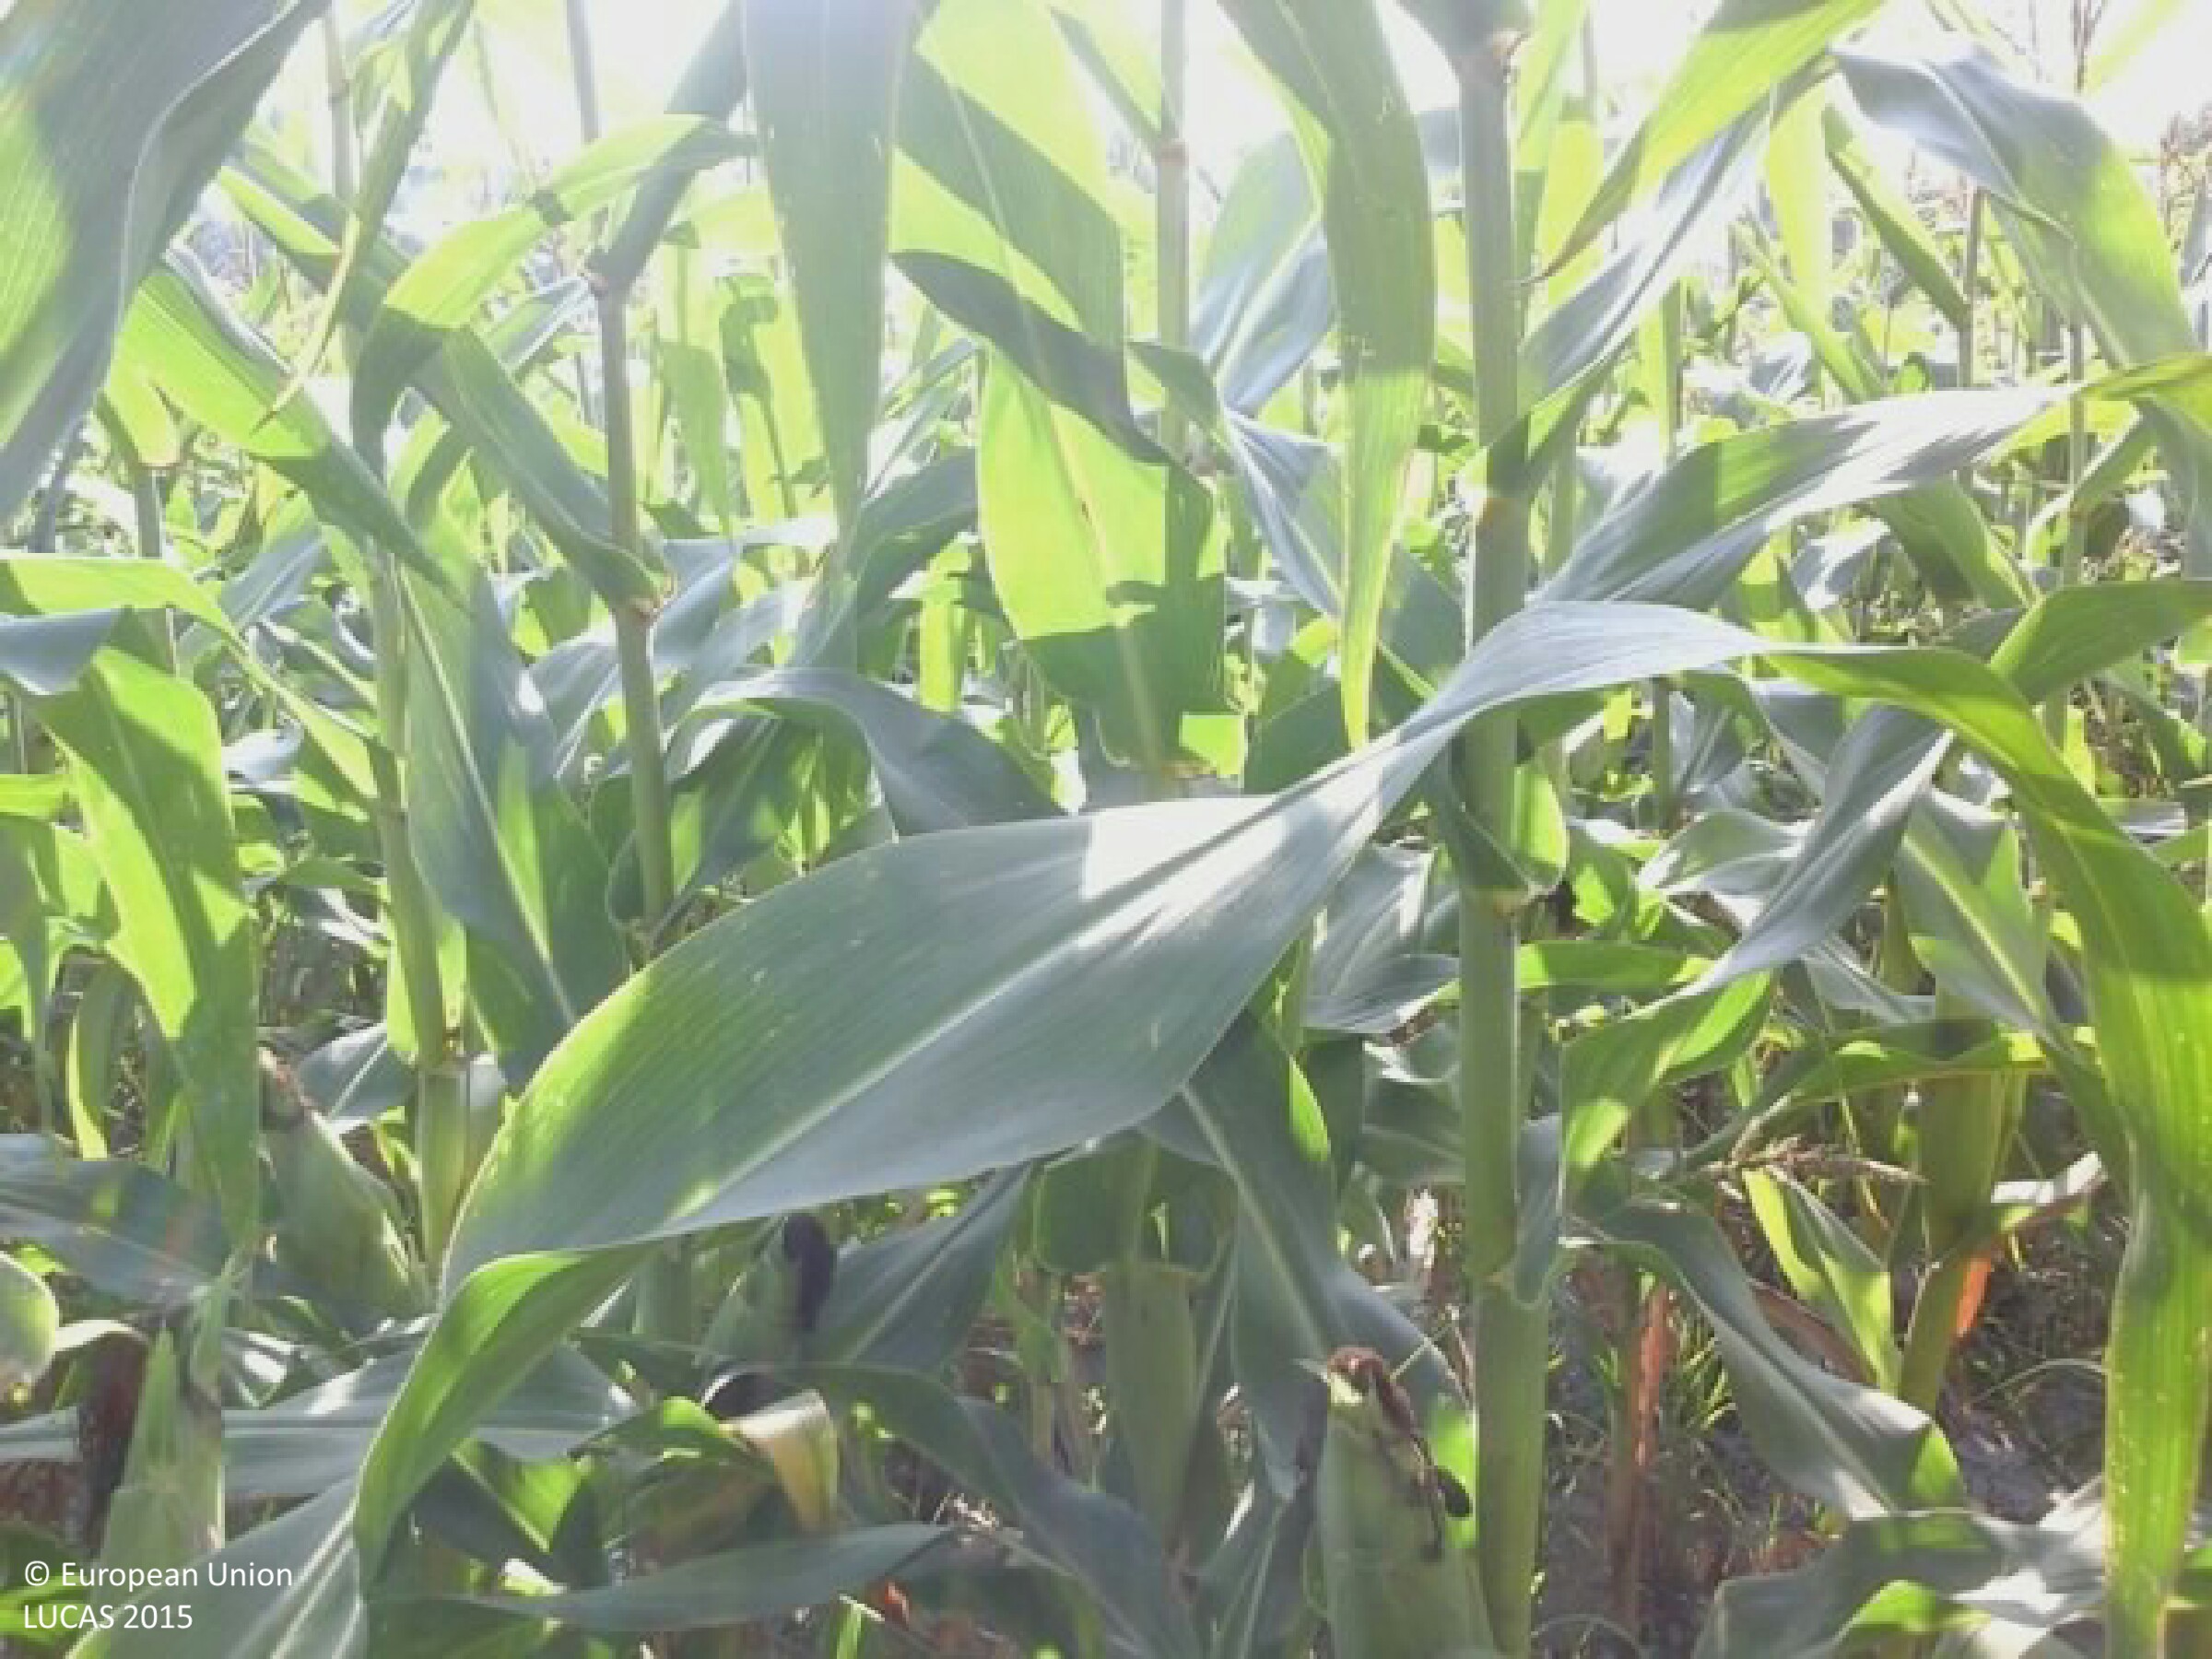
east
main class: Cropland
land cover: Maize
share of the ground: > 75 %
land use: Agriculture (excluding fallow land and kitchen gardens)
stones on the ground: < 10 %
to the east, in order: Maize; Broadleaved woodland; Grass margins; Tracks; Grass margins; Other bare soil
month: August
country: HU
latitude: 47.3007
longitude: 19.1300
